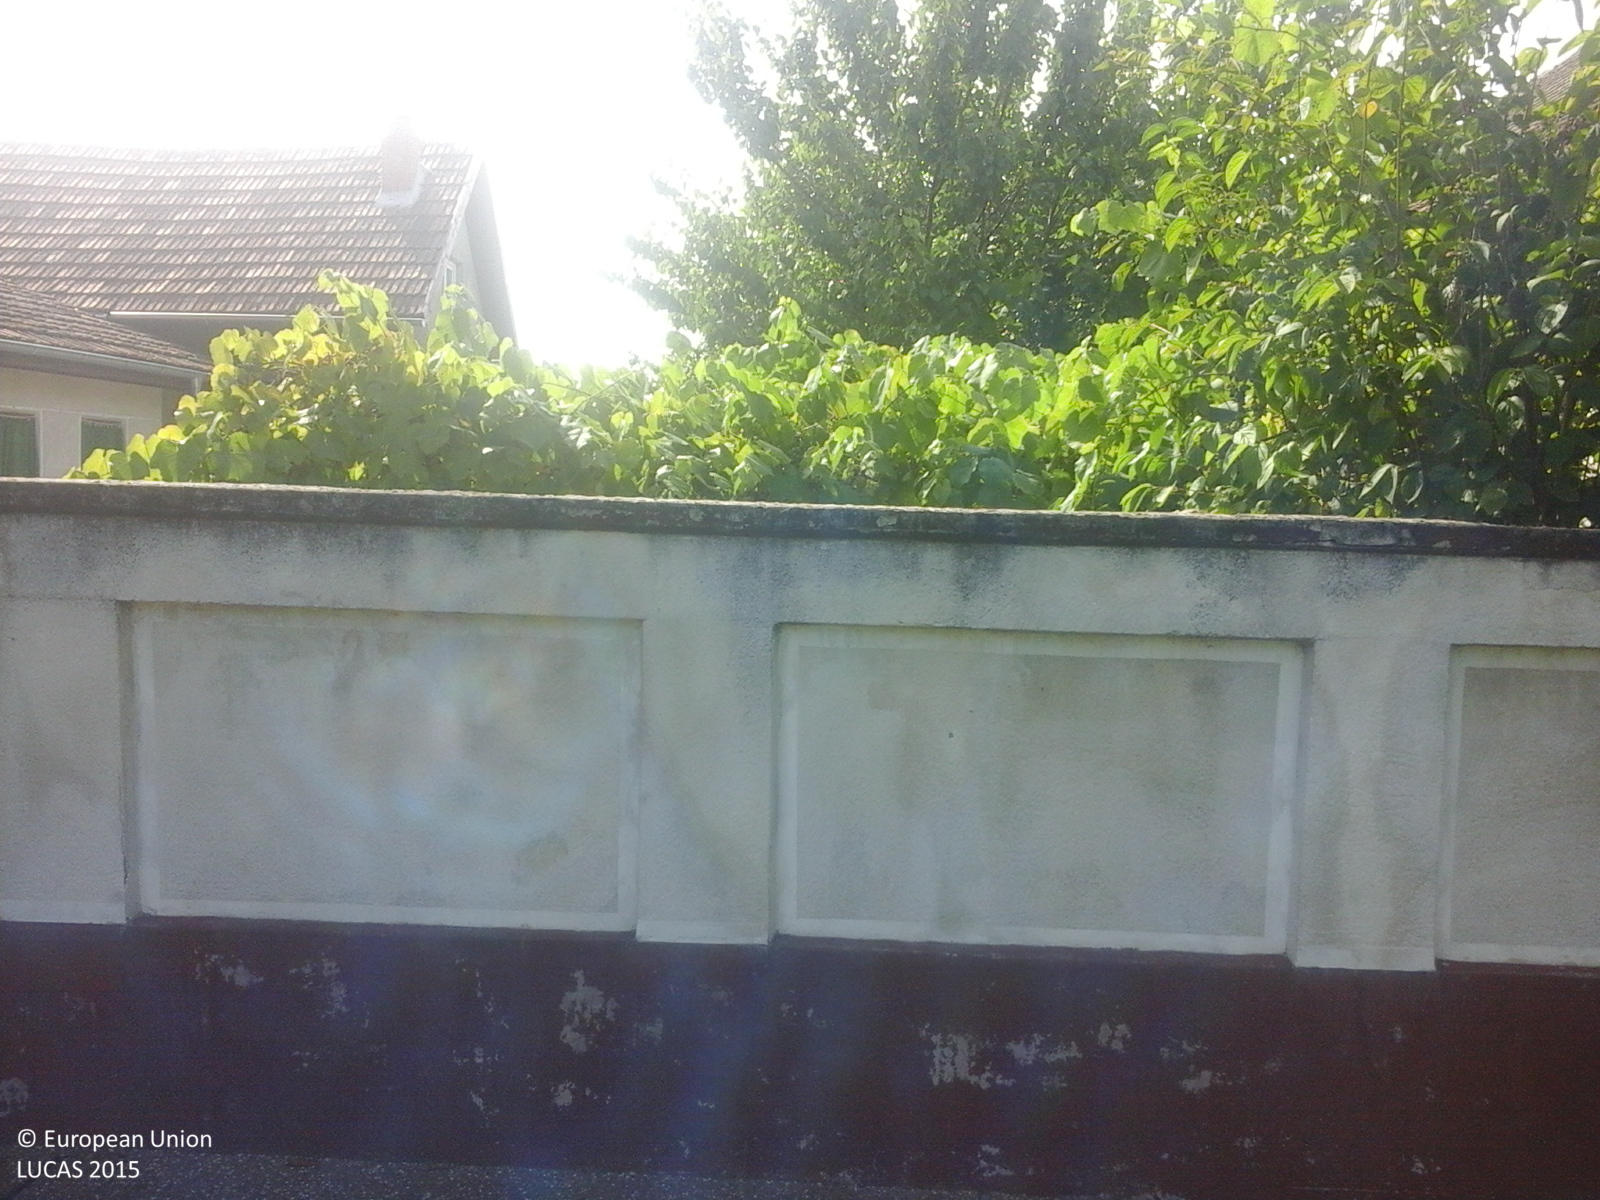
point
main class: Cropland
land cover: Vineyards
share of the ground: > 75 %
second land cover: Other bare soil
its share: > 75 %
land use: Kitchen garden
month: August
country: RO
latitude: 45.7617
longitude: 21.0213
